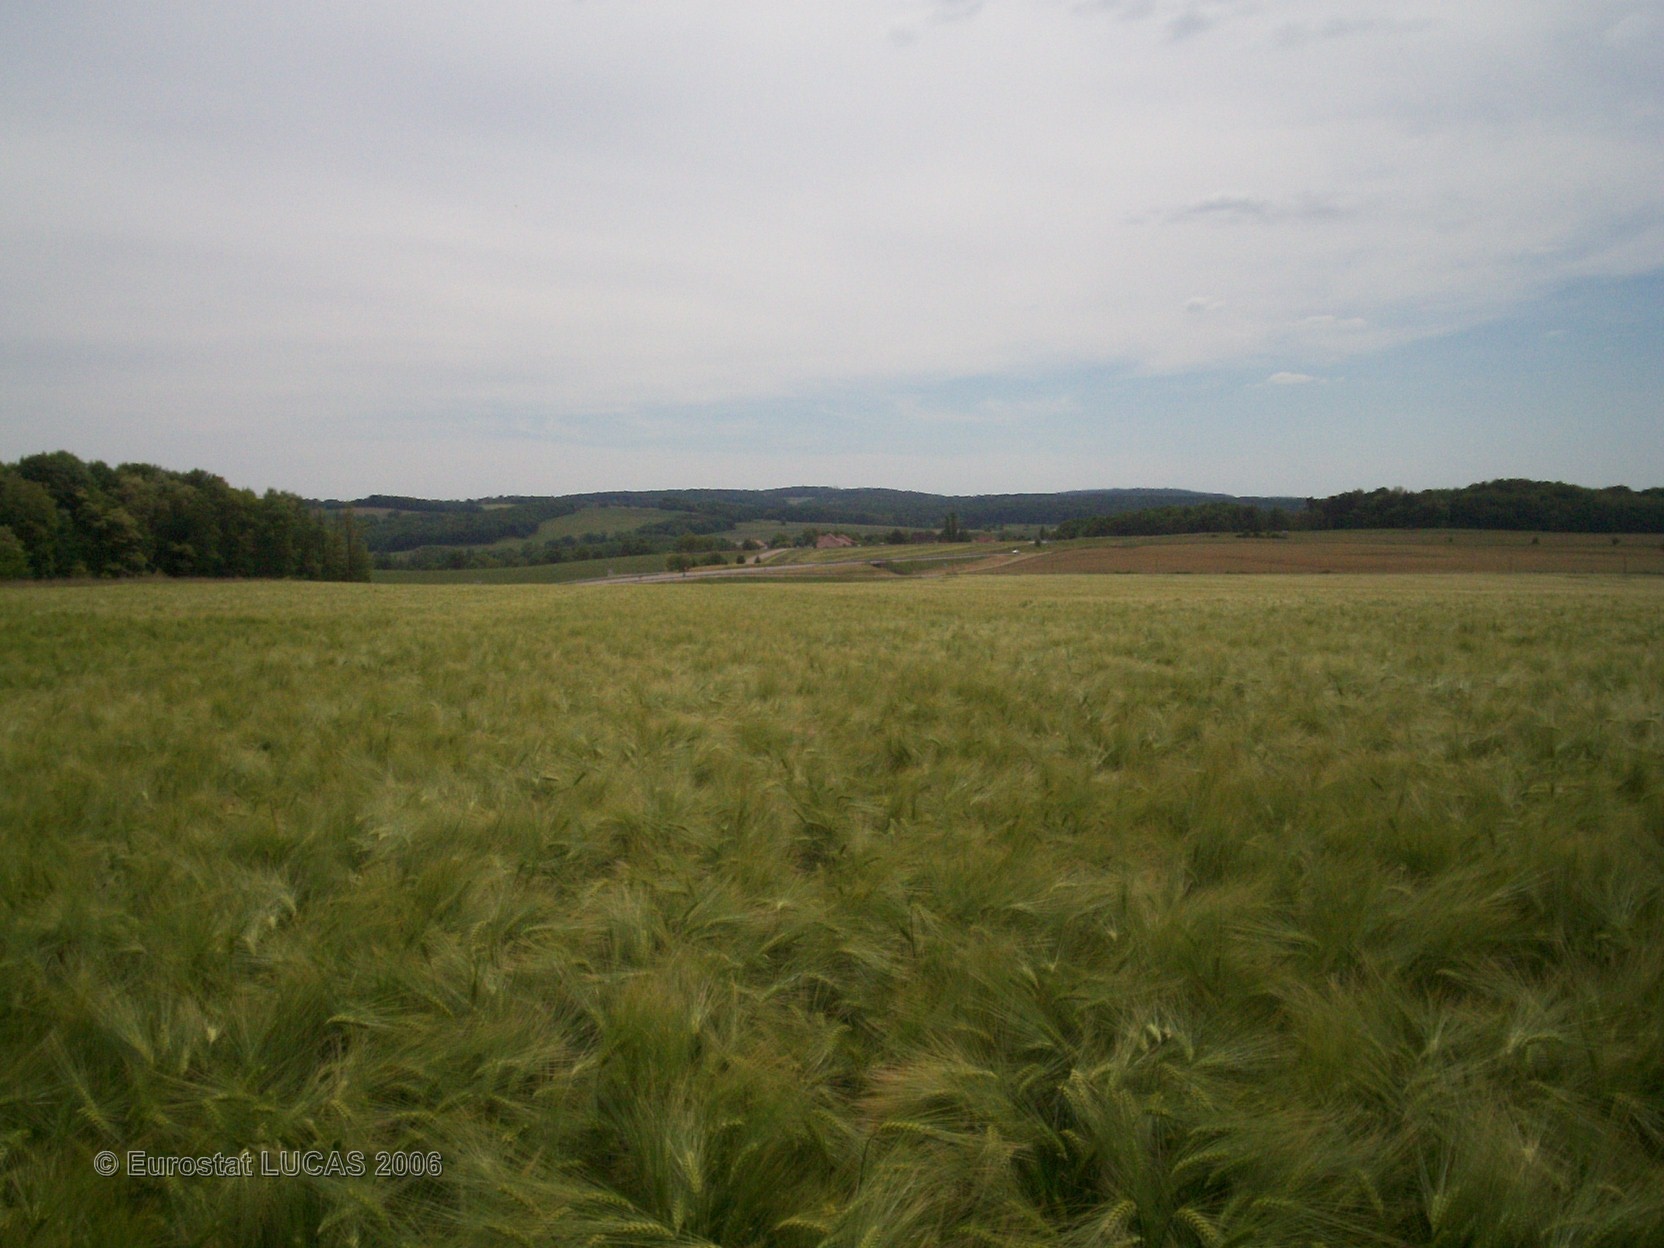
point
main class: Cropland
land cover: Barley
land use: Agriculture (excluding fallow land and kitchen gardens)
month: June
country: FR
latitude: 47.5205
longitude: 6.0039
